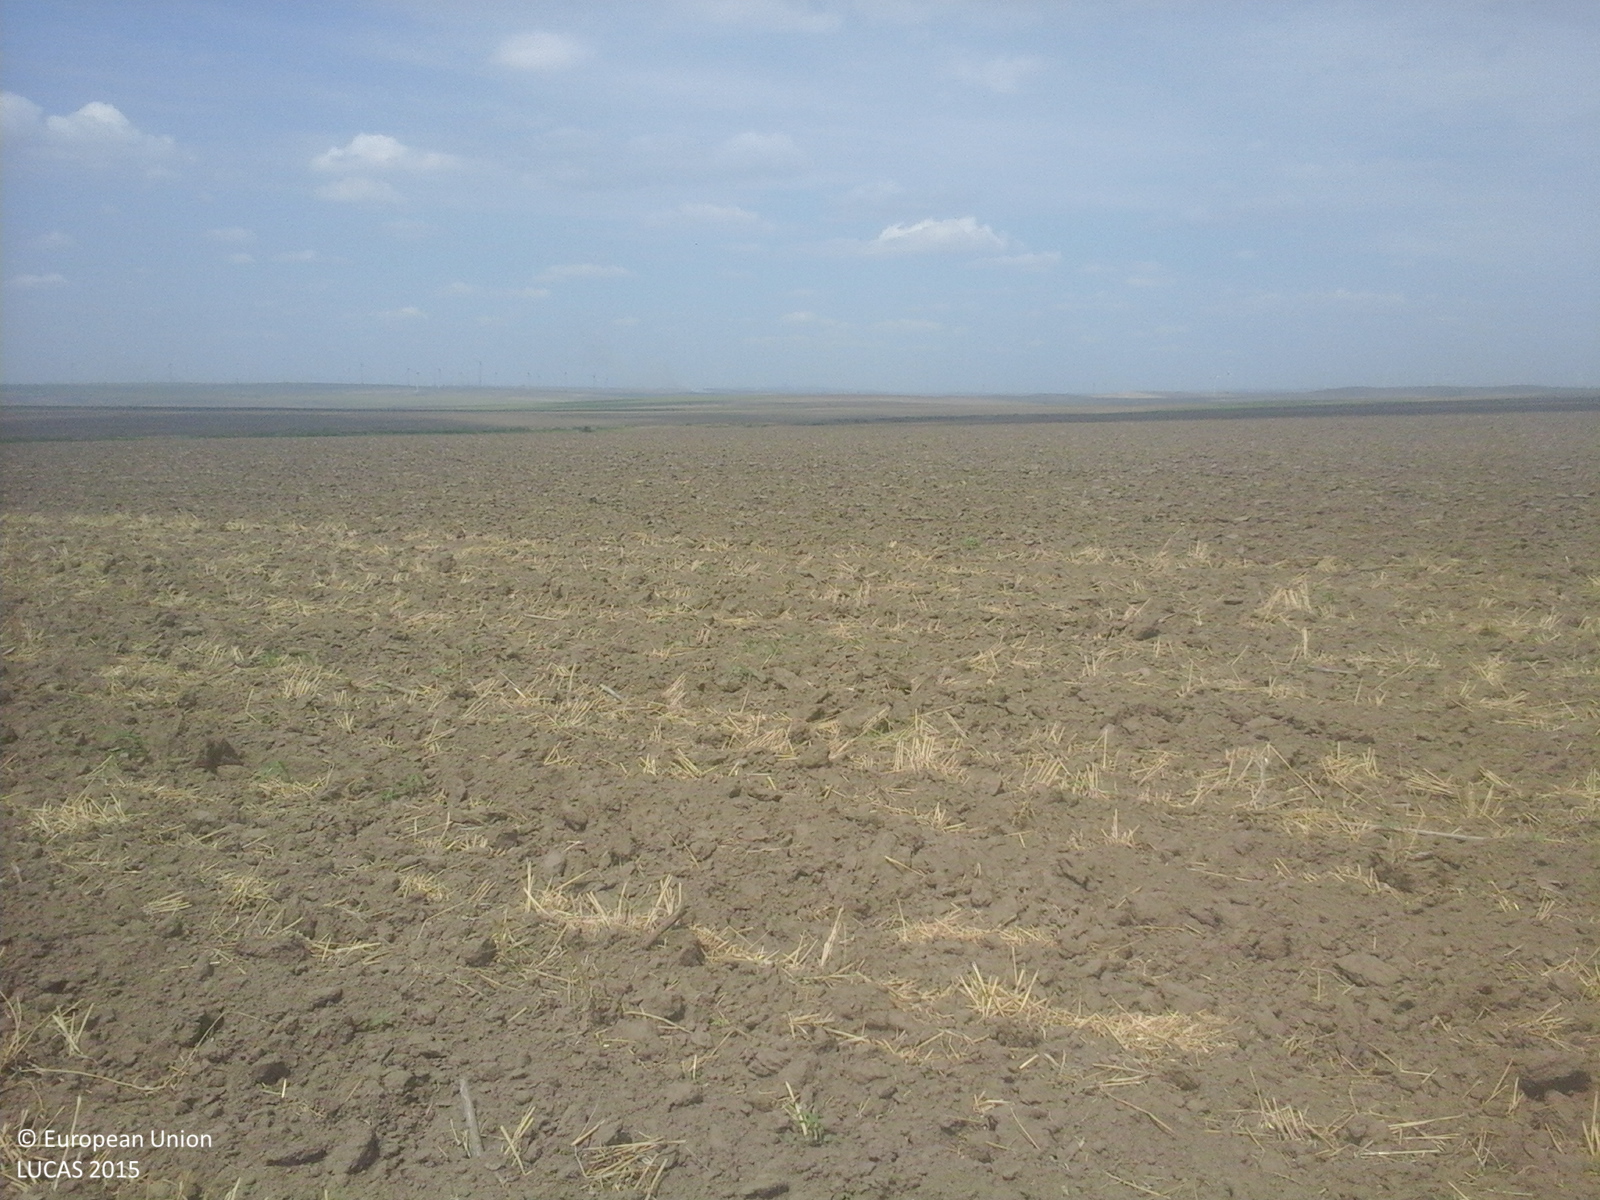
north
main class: Cropland
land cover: Common wheat
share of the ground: < 10 %
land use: Agriculture (excluding fallow land and kitchen gardens)
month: August
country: RO
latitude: 44.7030
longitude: 28.2799
